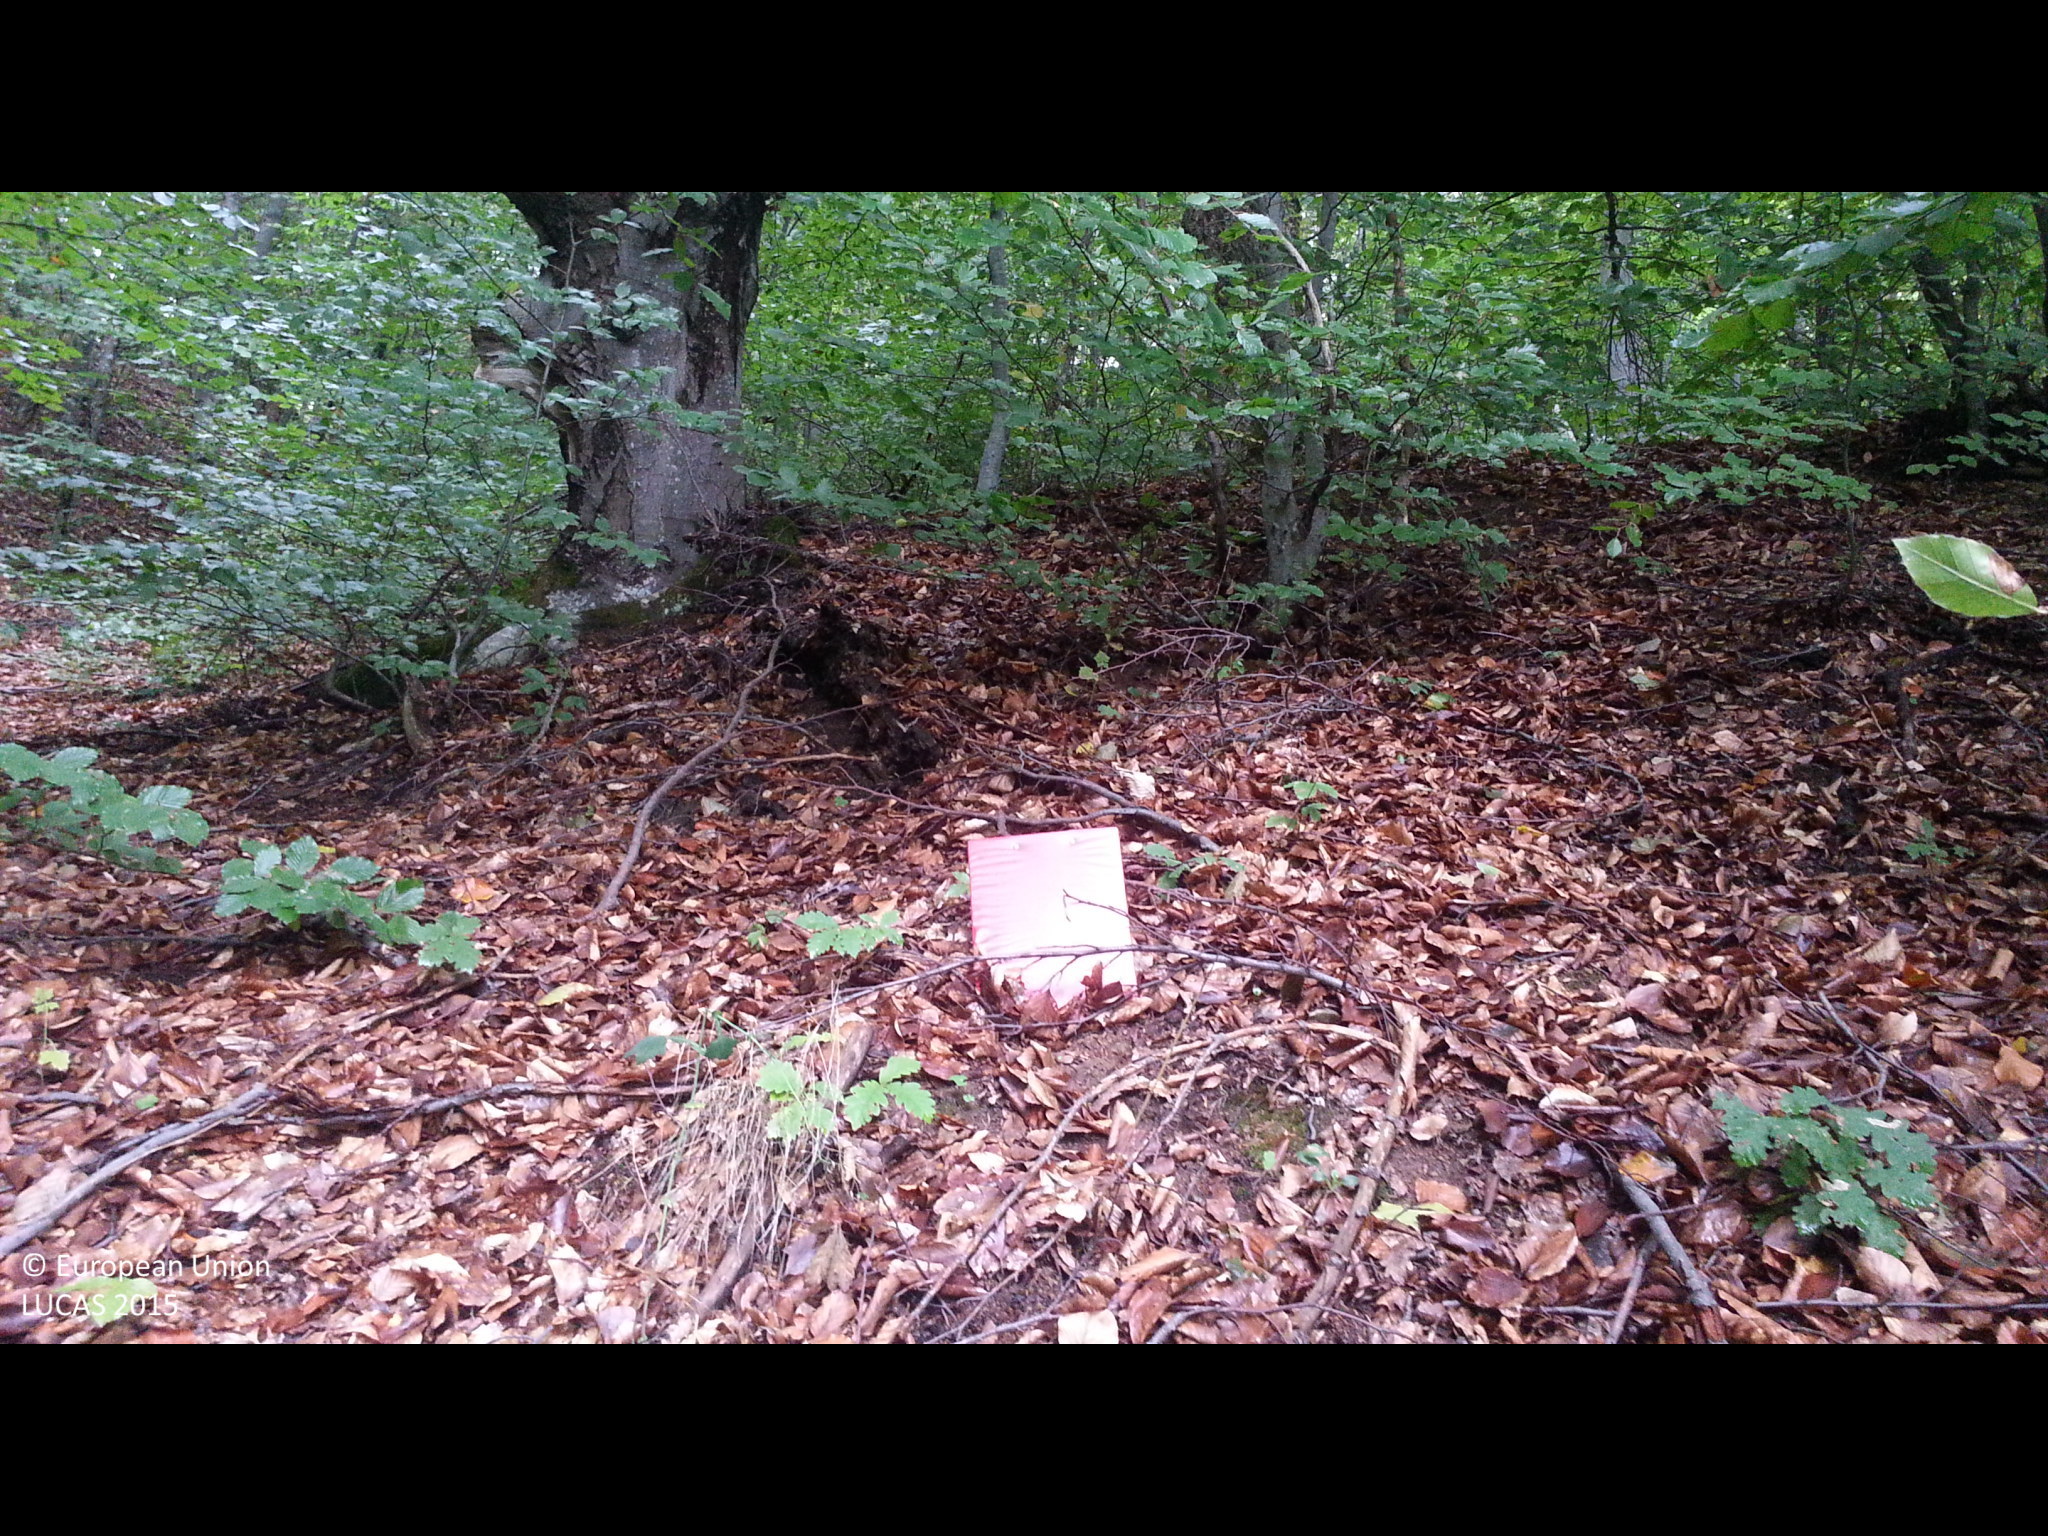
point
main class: Woodland
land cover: Broadleaved woodland
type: mountainous beech forest
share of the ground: > 75 %
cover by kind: broadleaved forest trees 95 %, shrubs 5 %
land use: Forestry
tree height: > 5 m
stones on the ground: < 10 %
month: September
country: BG
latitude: 42.3998
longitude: 22.5468
